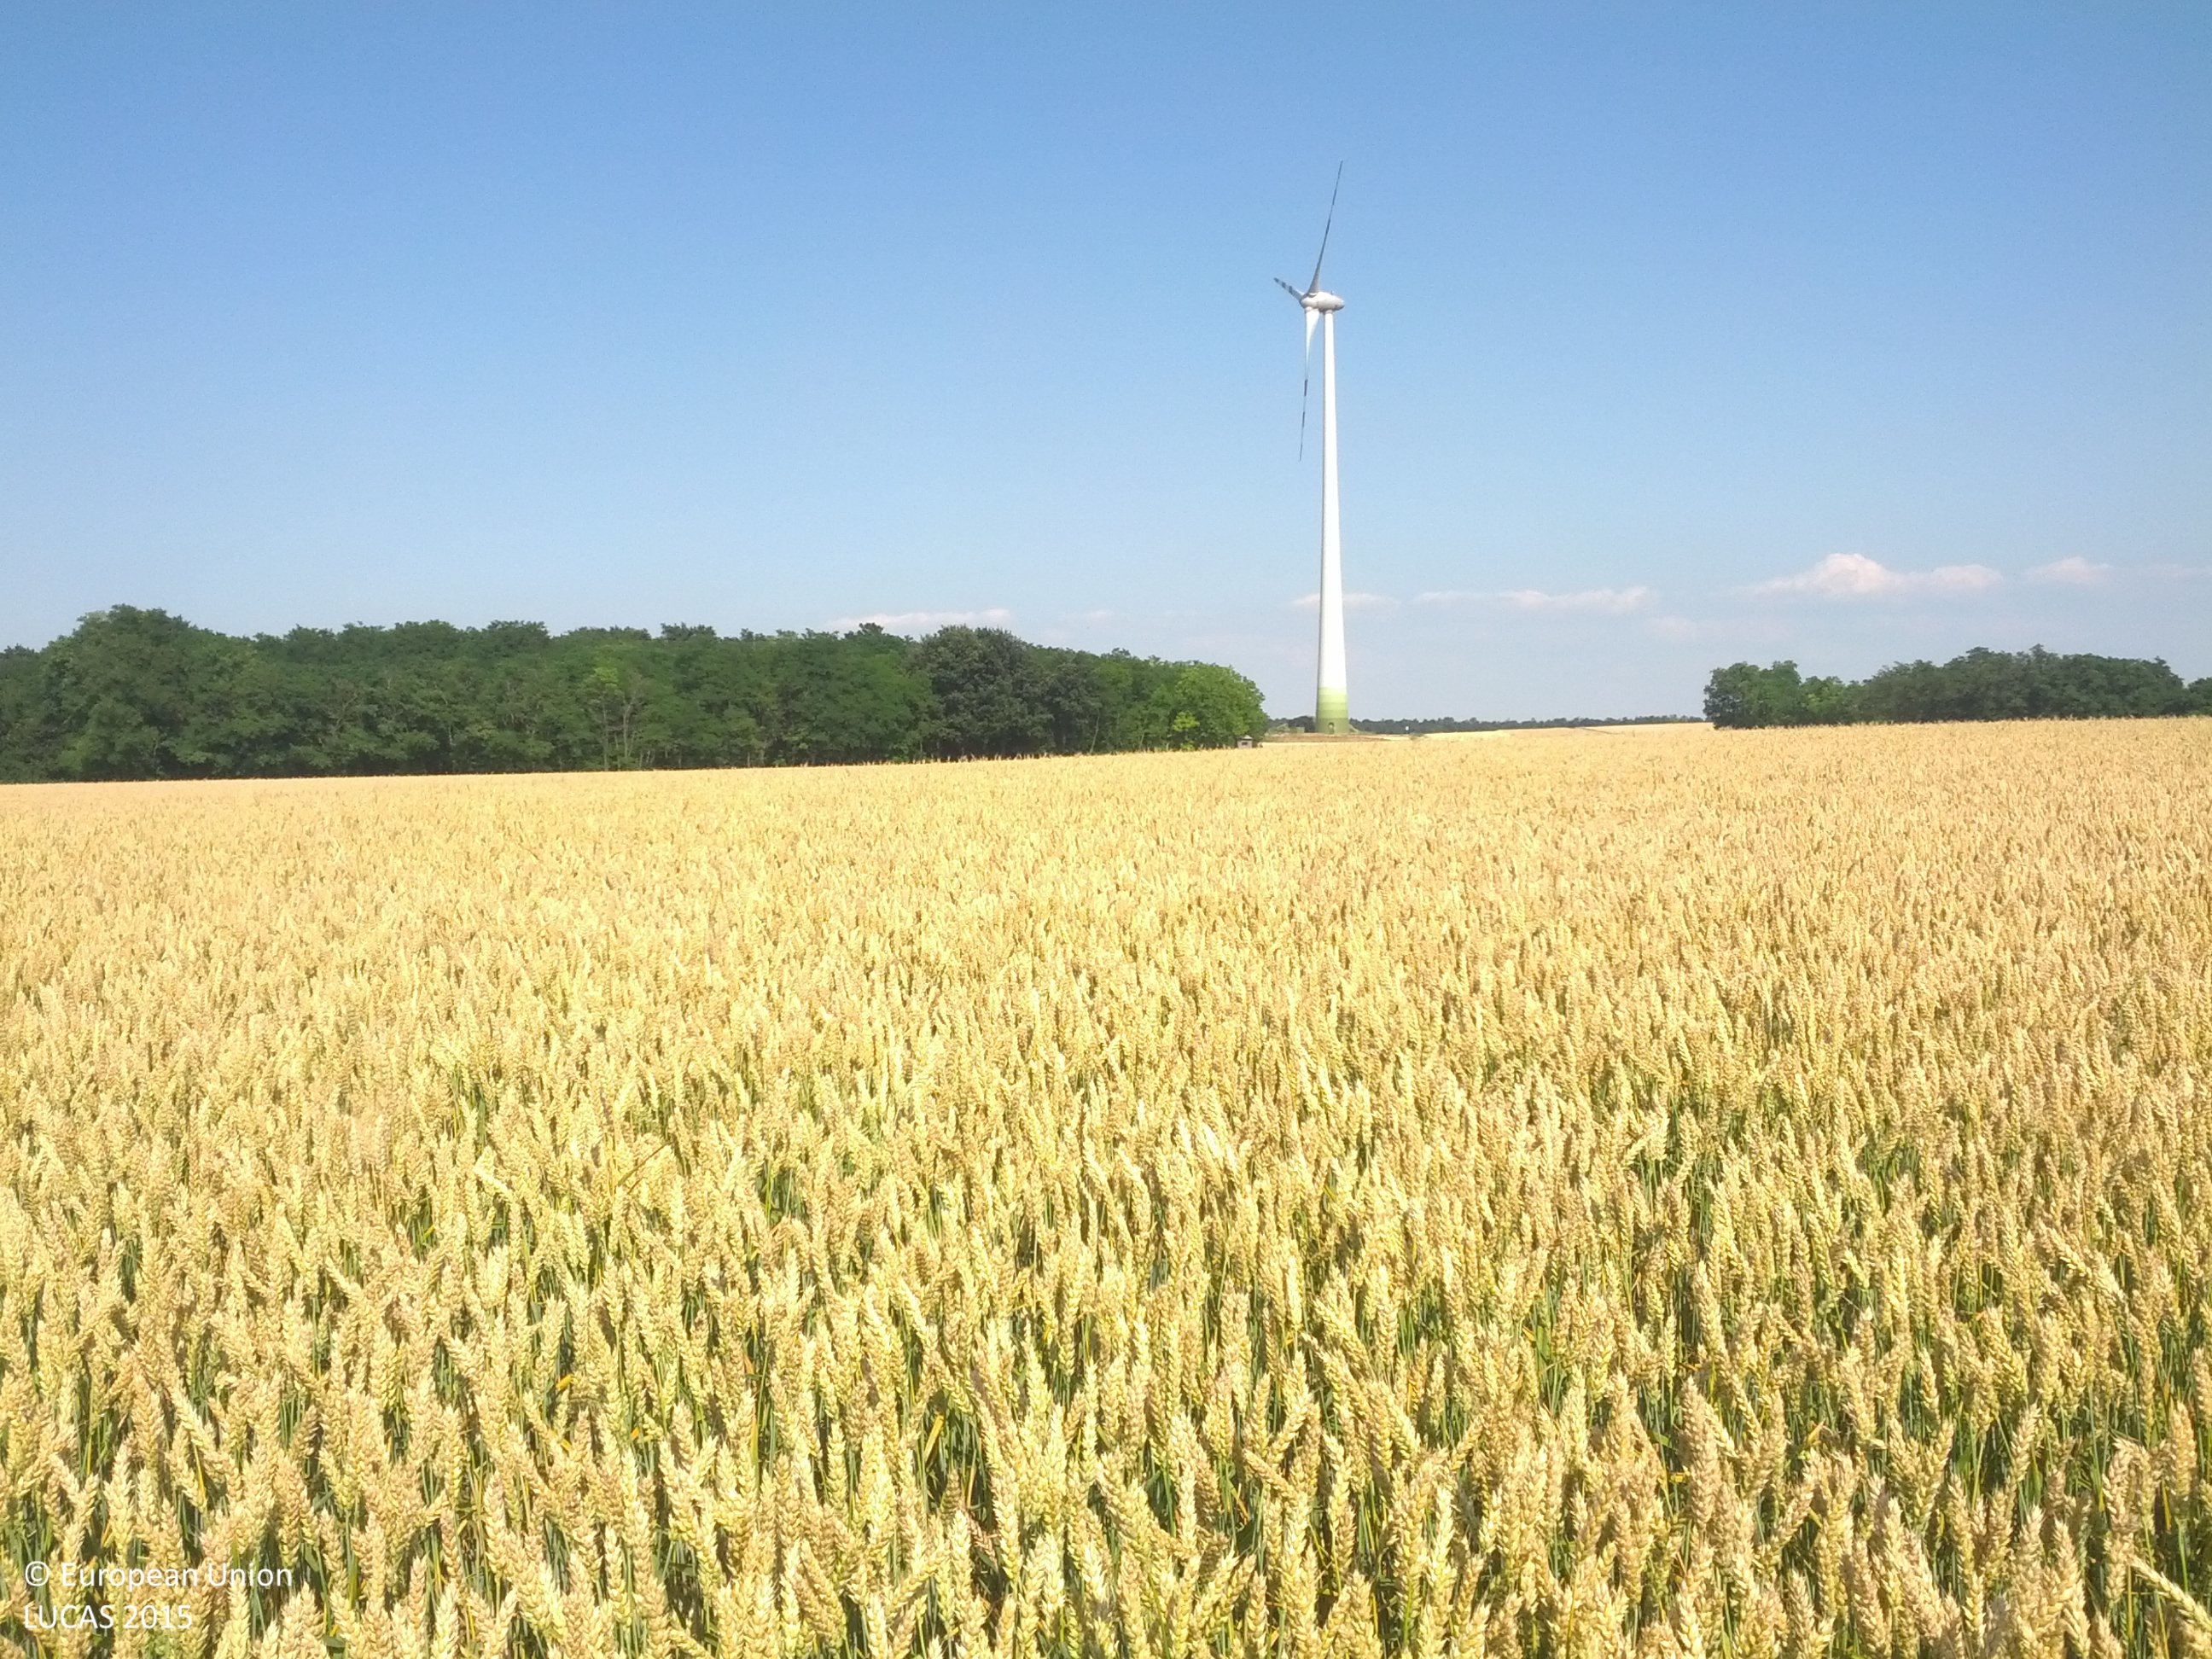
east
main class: Cropland
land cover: Common wheat
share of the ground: > 75 %
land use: Agriculture (excluding fallow land and kitchen gardens)
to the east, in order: Common wheat; Tracks; Broadleaved woodland
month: July
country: AT
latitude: 48.5279
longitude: 16.6554
